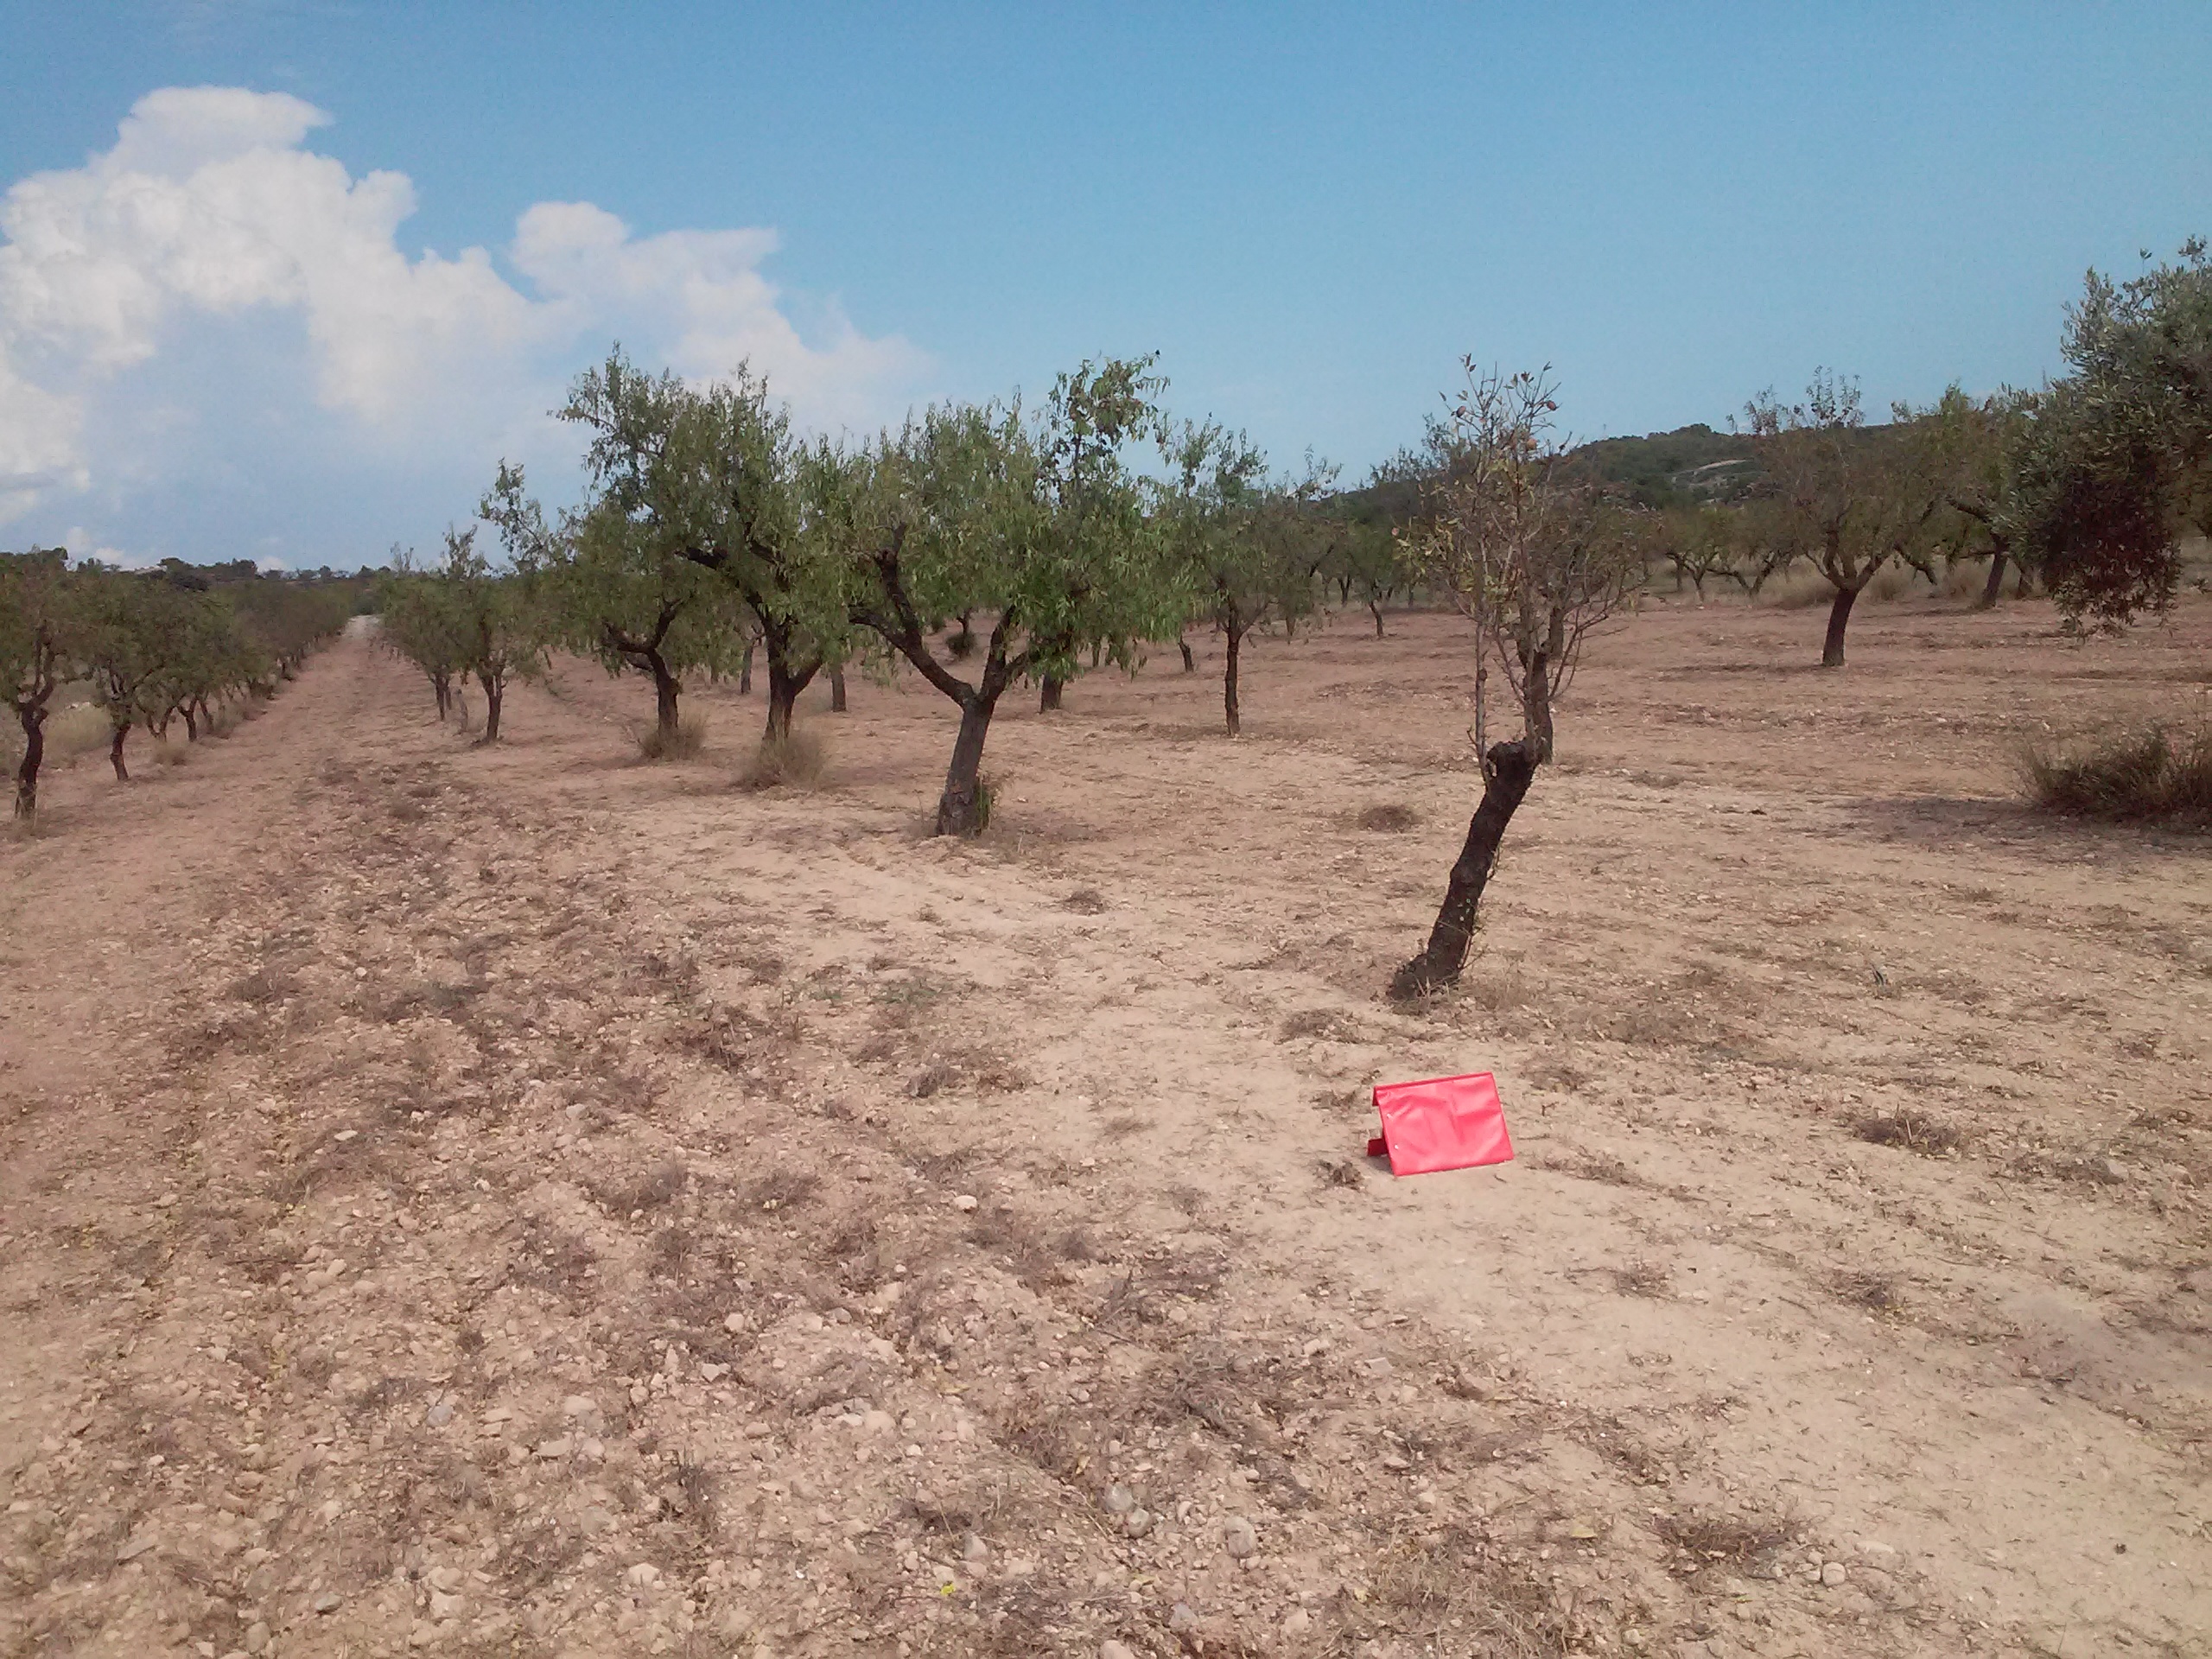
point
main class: Cropland
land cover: Nuts trees
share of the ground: 10 - 25 %
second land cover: Other bare soil
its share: > 75 %
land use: Agriculture (excluding fallow land and kitchen gardens)
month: August
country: ES
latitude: 41.0462
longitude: 0.5340
